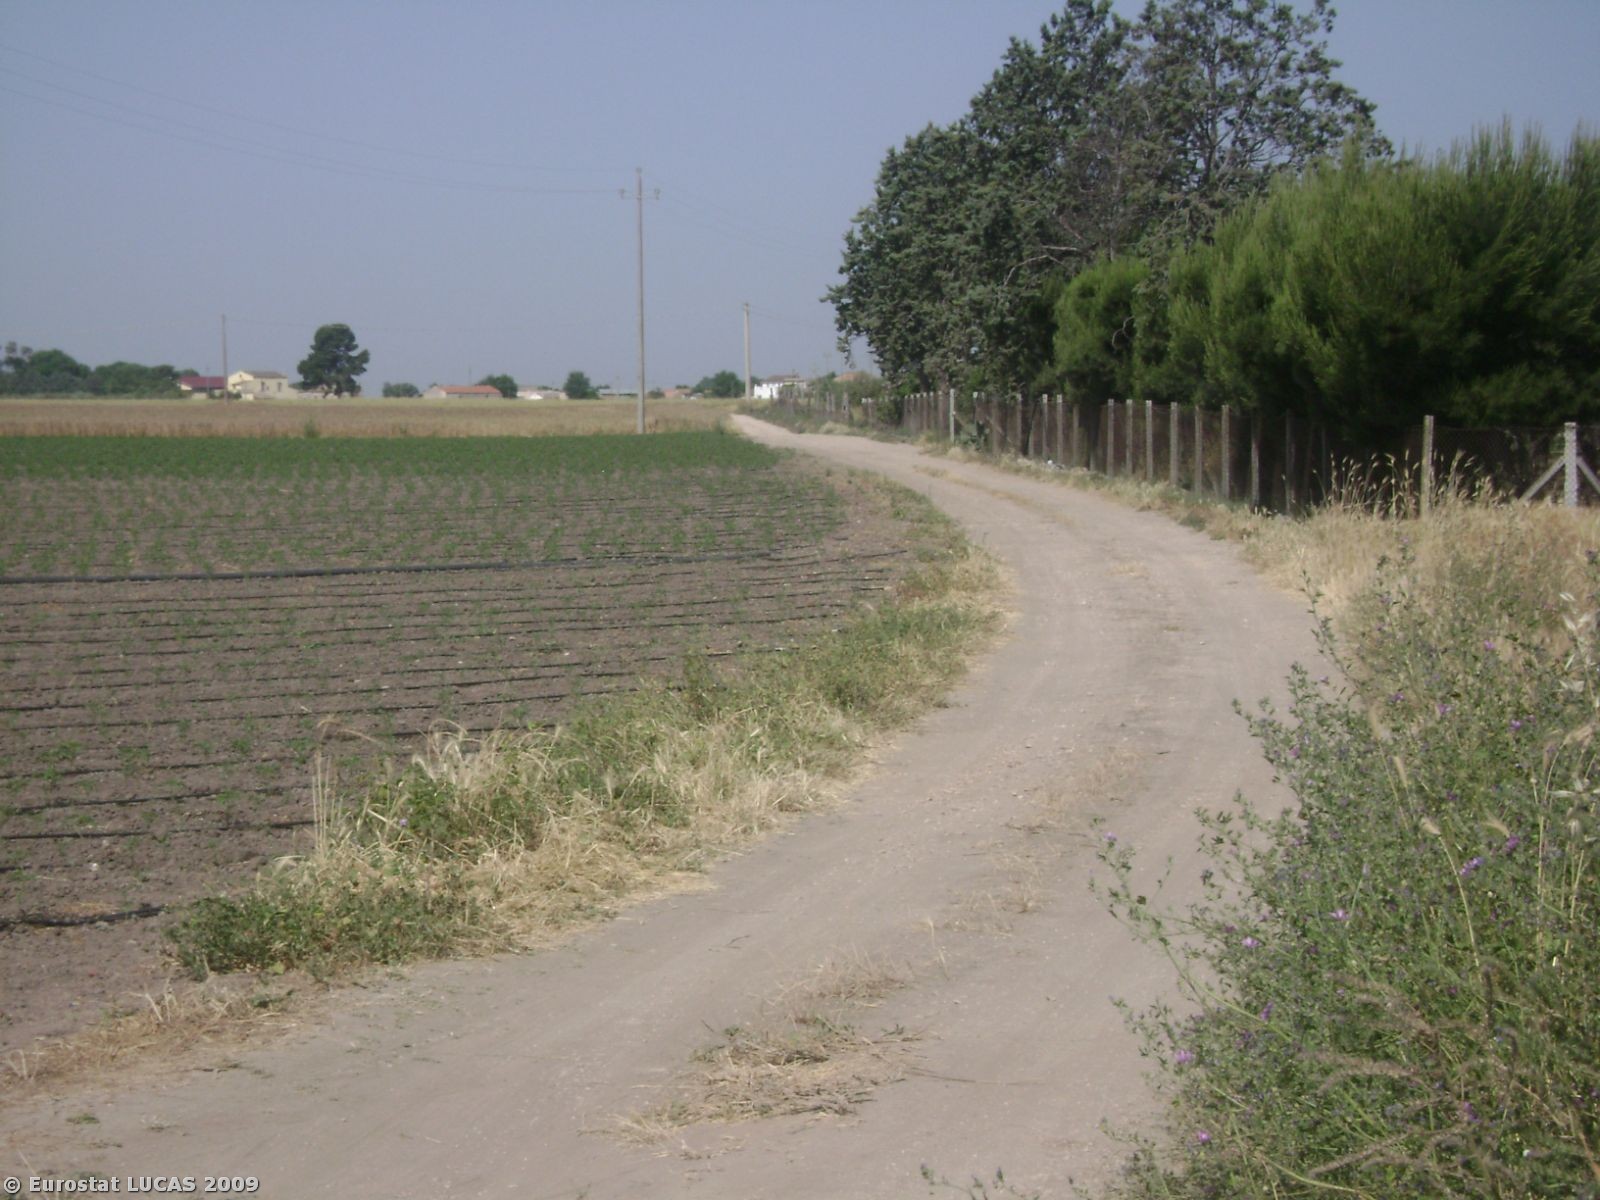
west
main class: Cropland
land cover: Durum wheat
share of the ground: > 75 %
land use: Agriculture (excluding fallow land and kitchen gardens)
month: May
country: IT
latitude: 41.5878
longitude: 15.7042
